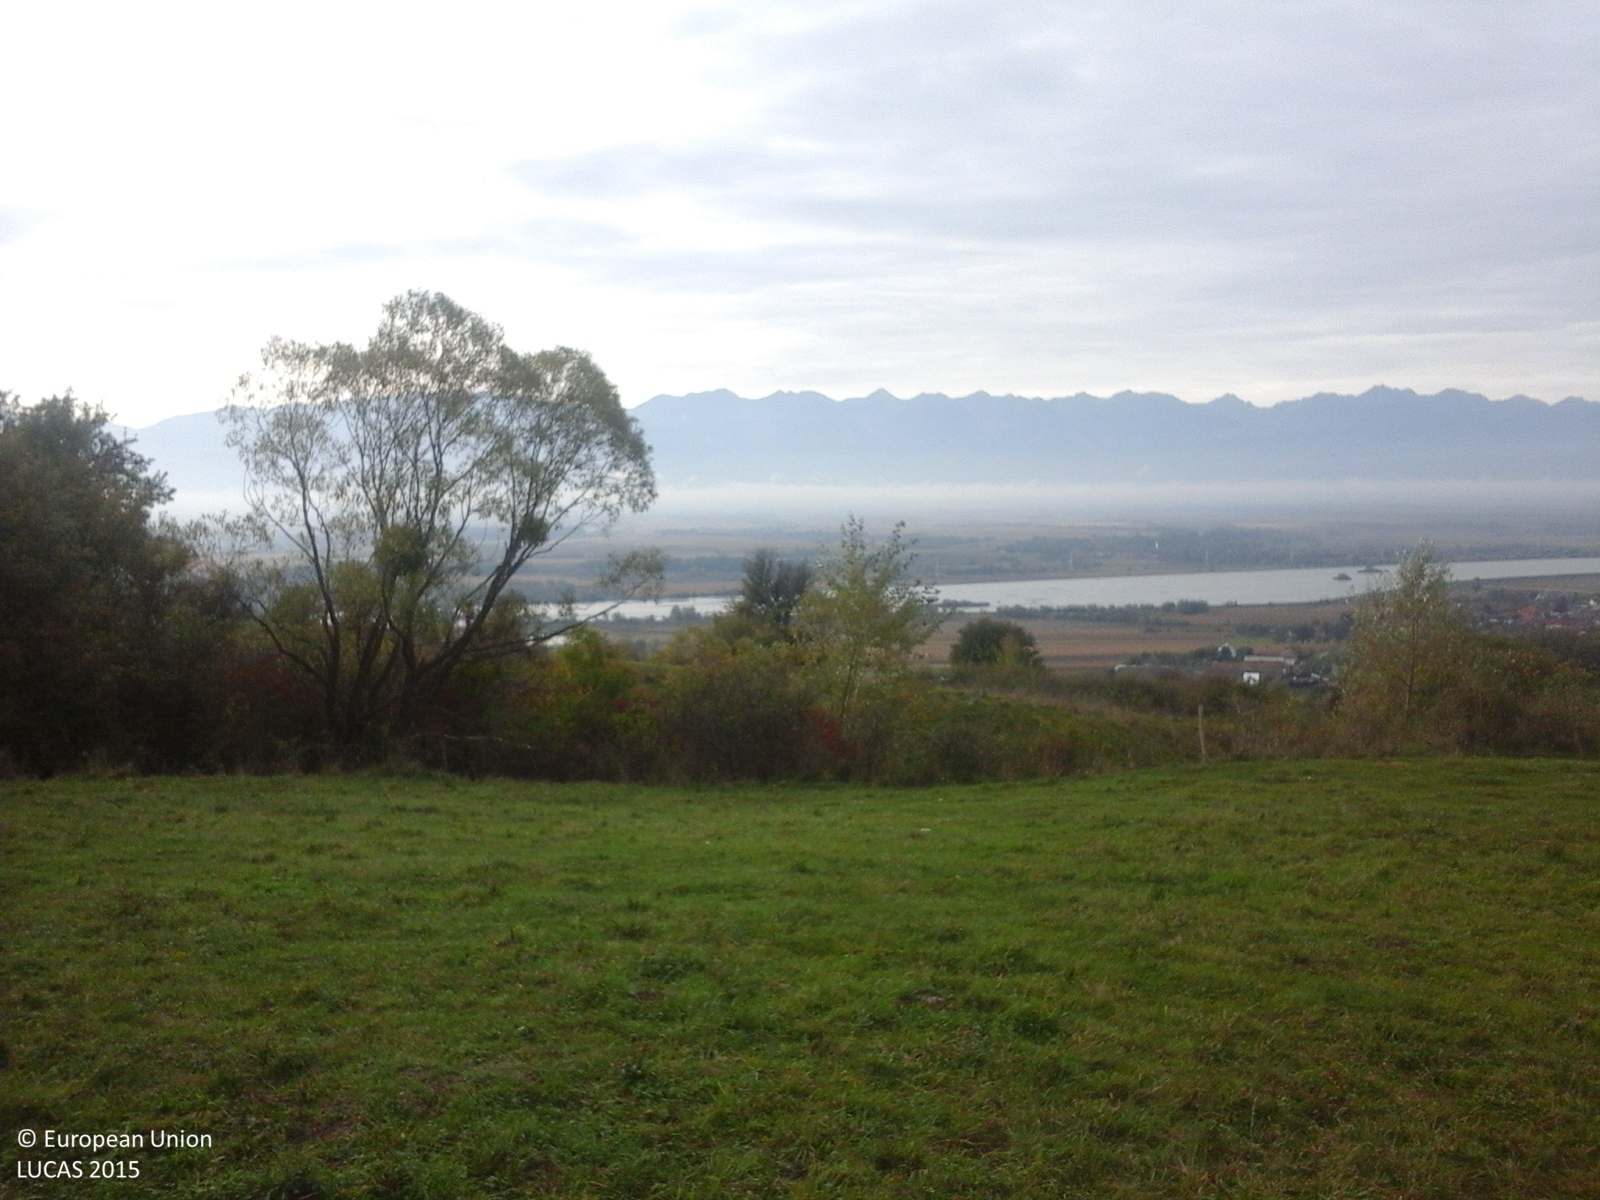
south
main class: Grassland
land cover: Grassland without tree/shrub cover
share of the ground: > 75 %
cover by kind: herbaceous plants 100 %
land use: Agriculture (excluding fallow land and kitchen gardens)
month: October
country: RO
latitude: 45.8304
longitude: 24.7759
